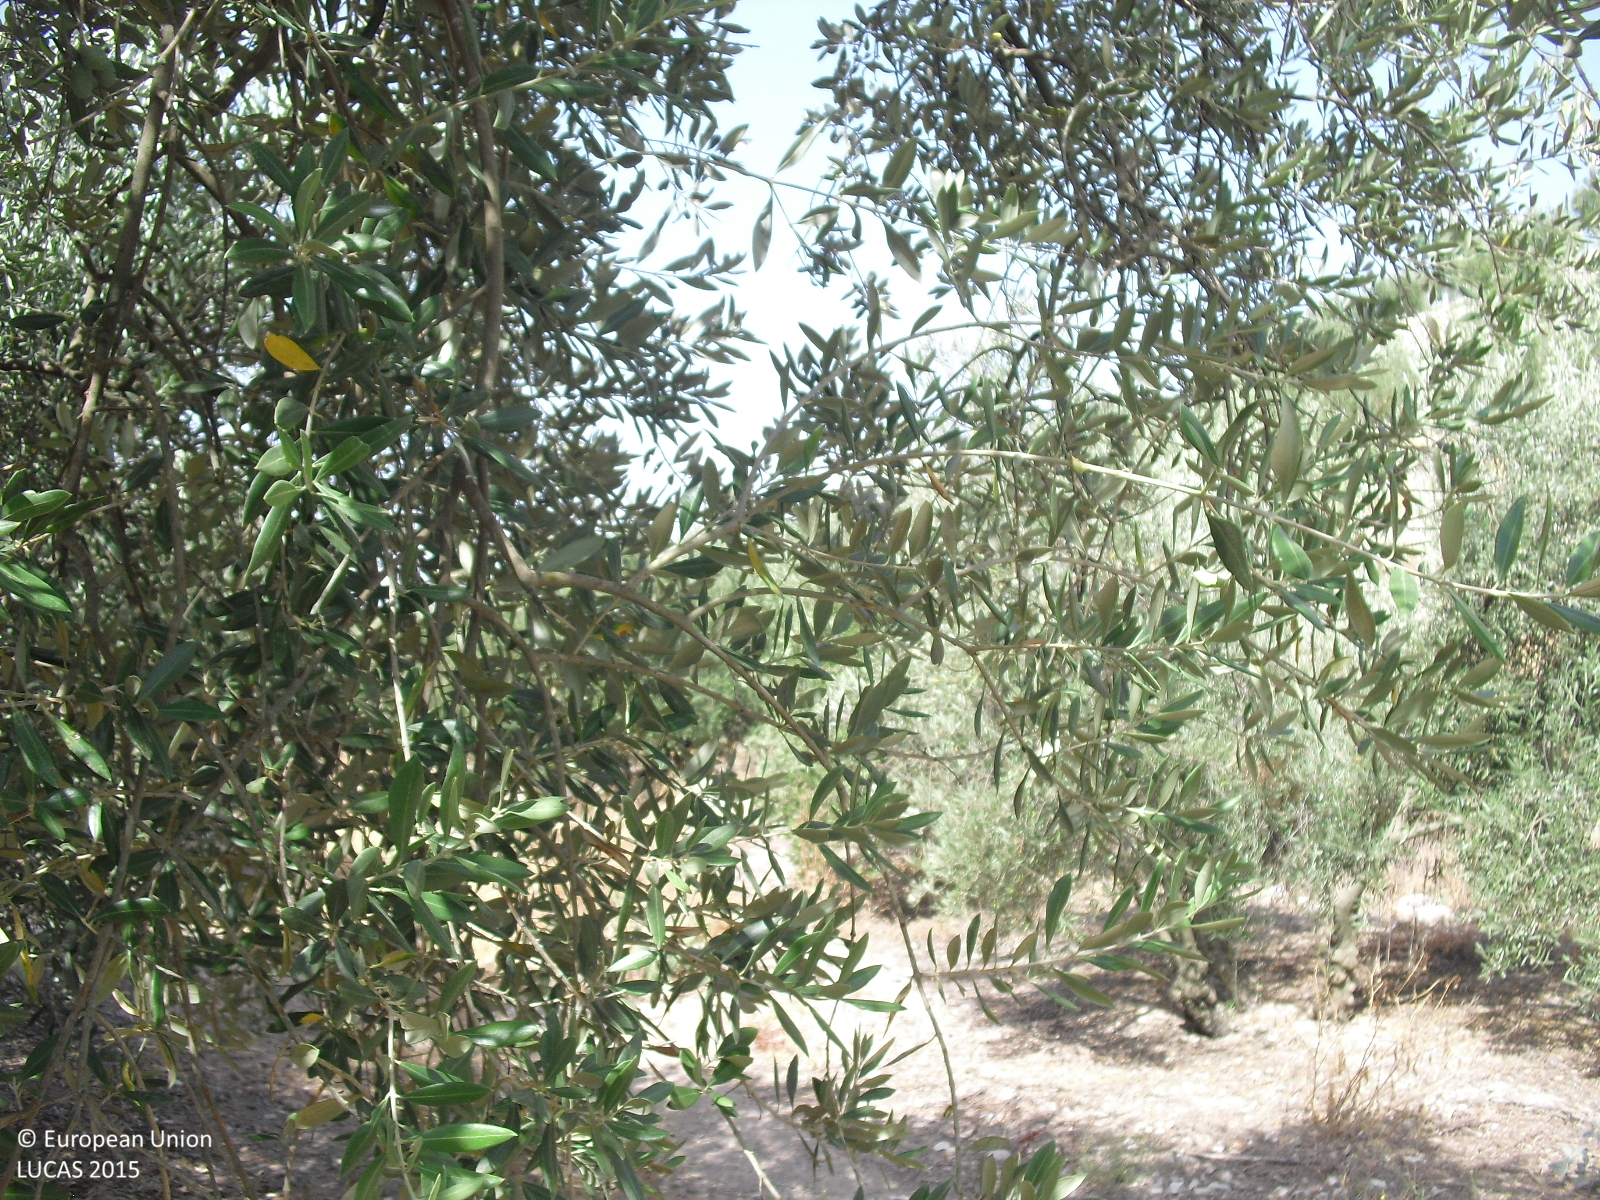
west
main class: Cropland
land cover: Olive groves
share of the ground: 25 - 50 %
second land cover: Spontaneously vegetated surfaces
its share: 10 - 25 %
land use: Agriculture (excluding fallow land and kitchen gardens)
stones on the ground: 10 - 25 %
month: August
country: ES
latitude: 37.3220
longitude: -4.1826
